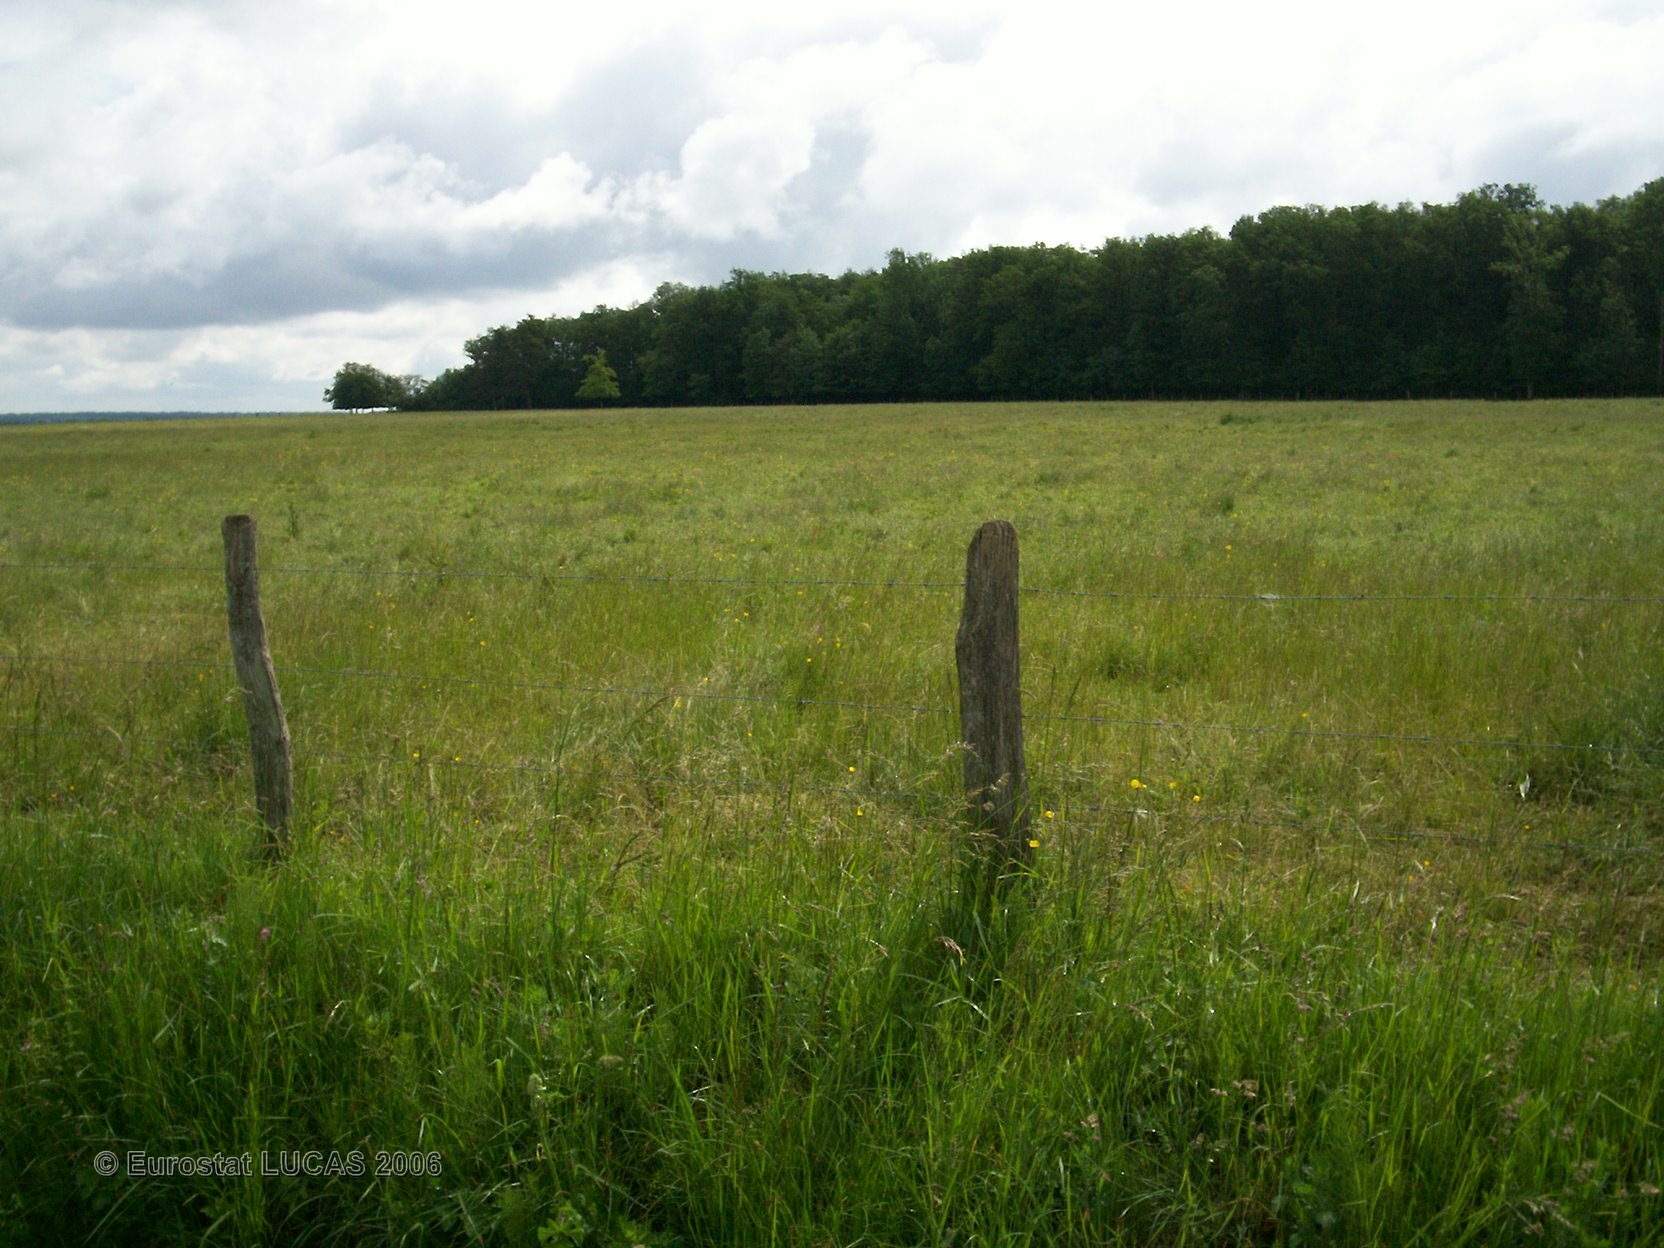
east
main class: Grassland
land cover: Grassland without tree/shrub cover
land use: Agriculture (excluding fallow land and kitchen gardens)
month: May
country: FR
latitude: 48.3046
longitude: 4.5374
